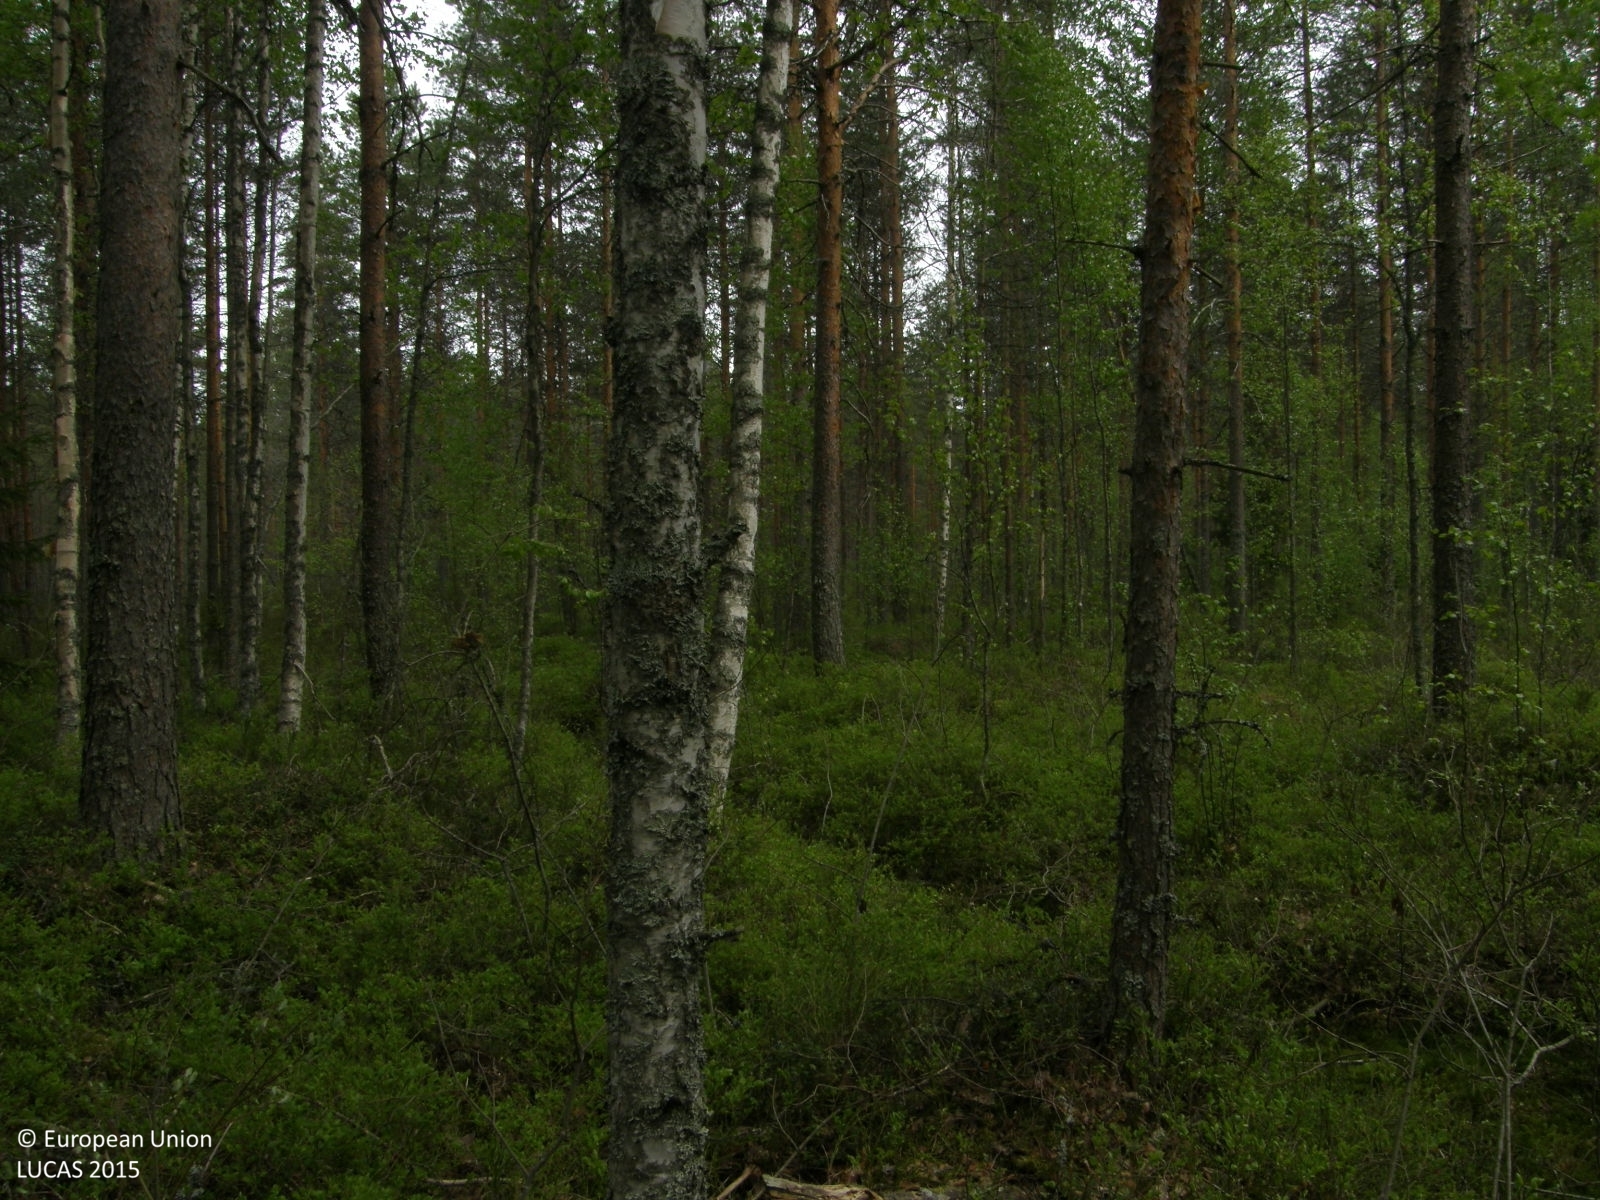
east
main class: Woodland
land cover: Pine dominated mixed woodland
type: boreal forest
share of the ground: > 75 %
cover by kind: coniferous forest trees 55 %, broadleaved forest trees 35 %, shrubs 10 %
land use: Forestry
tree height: > 5 m
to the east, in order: Pine dominated mixed woodland; Ditches and canals; Pine dominated mixed woodland; Pine dominated coniferous woodland; Ditches and canals; Pine dominated coniferous woodland
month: June
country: FI
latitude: 62.0643
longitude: 22.3605
